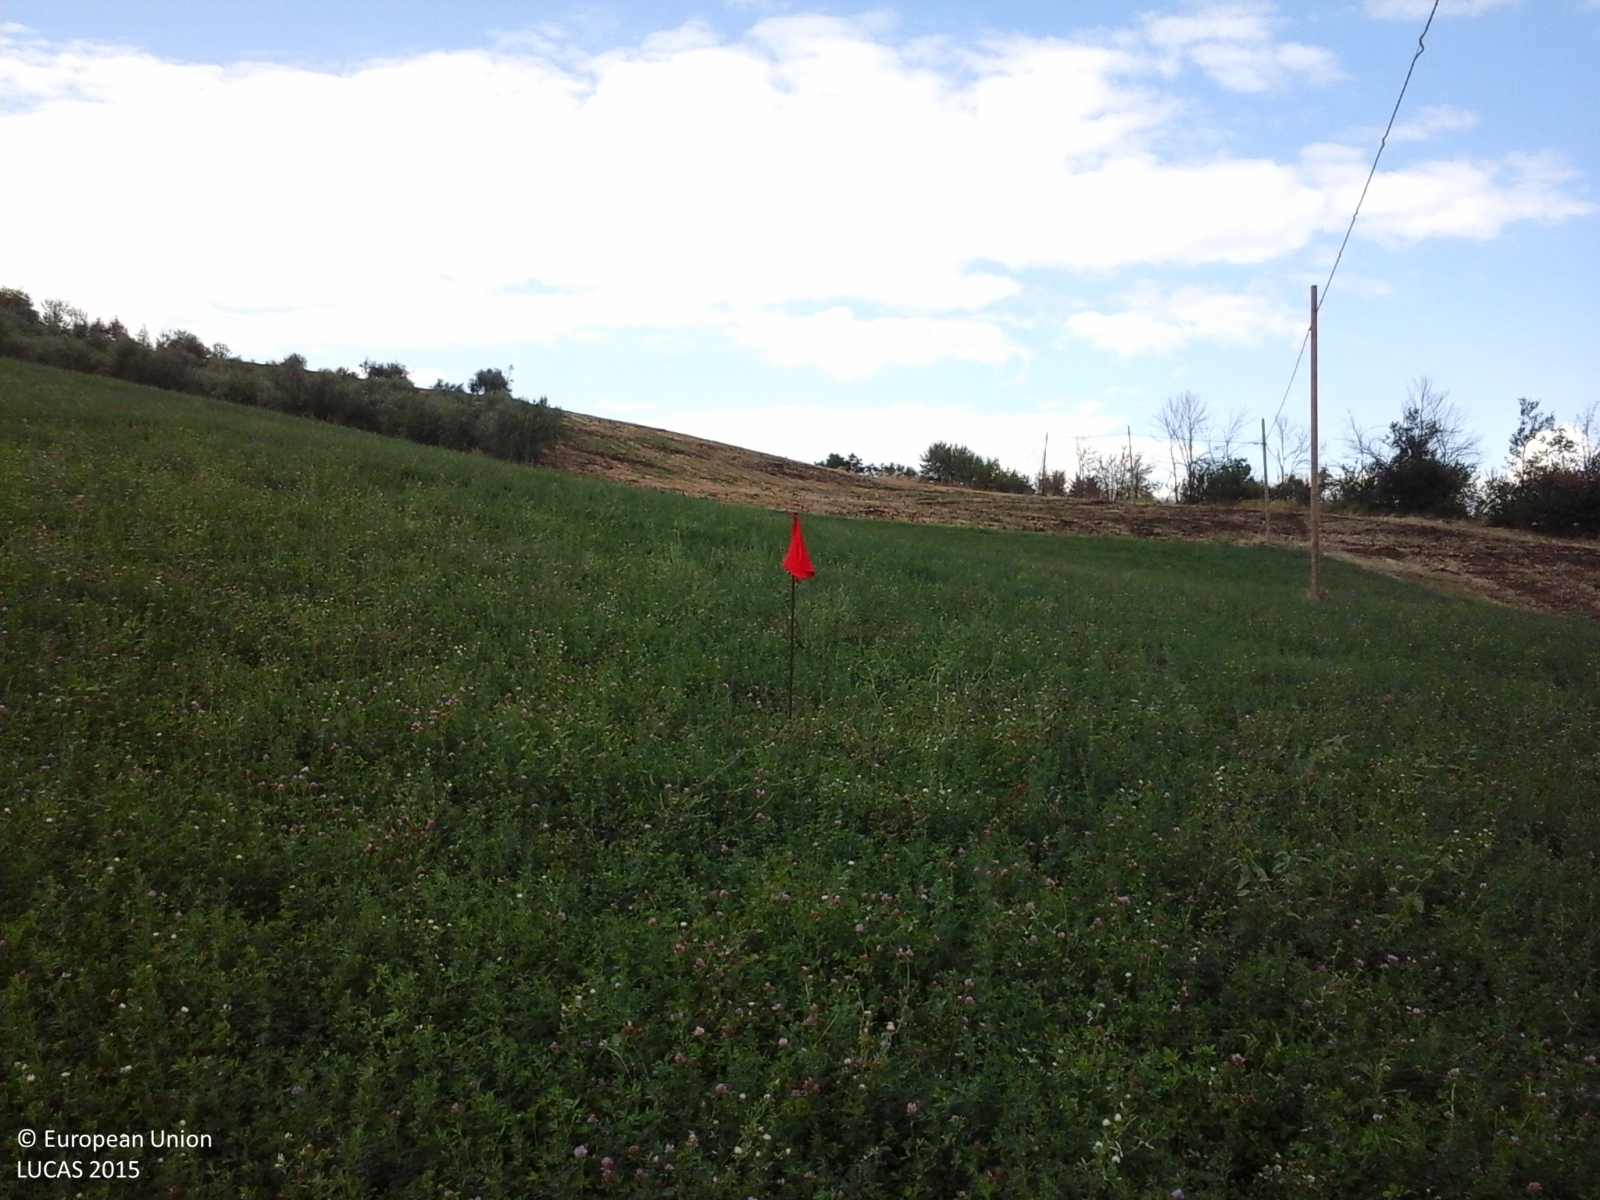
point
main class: Cropland
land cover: Lucerne
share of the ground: > 75 %
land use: Agriculture (excluding fallow land and kitchen gardens)
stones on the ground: < 10 %
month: August
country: IT
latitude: 42.5628
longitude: 13.8499
